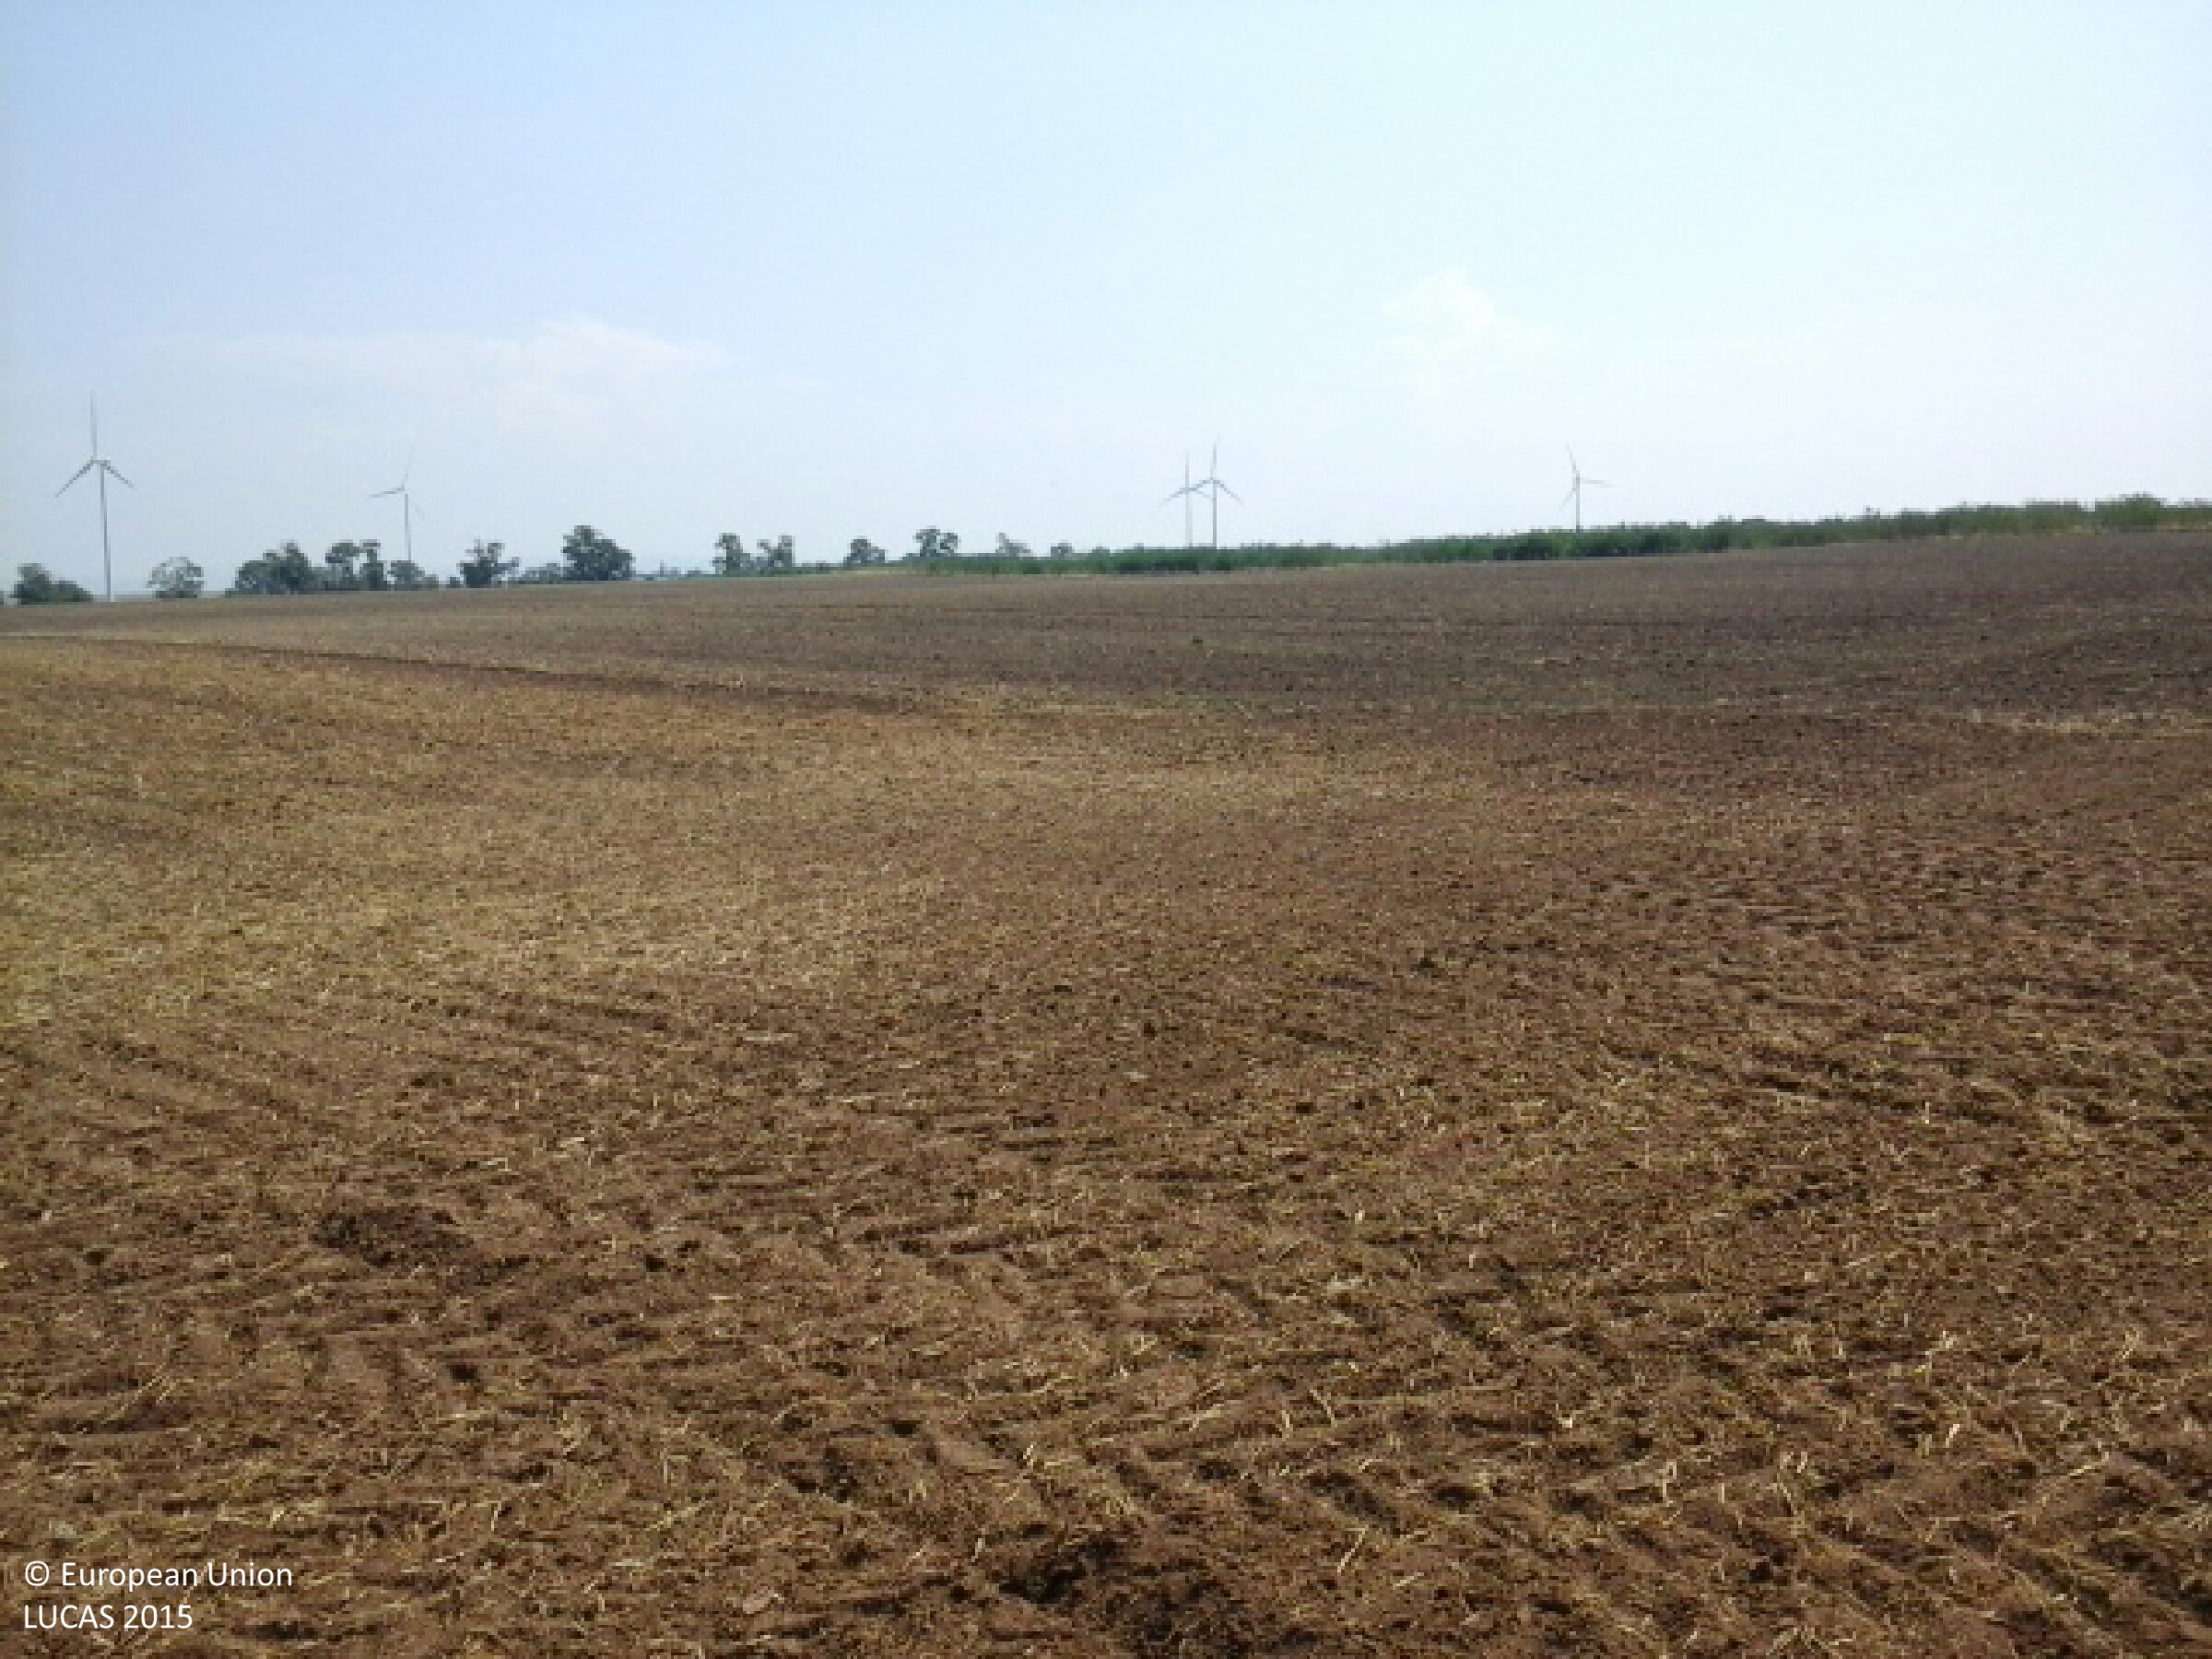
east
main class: Cropland
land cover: Common wheat
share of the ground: < 10 %
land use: Agriculture (excluding fallow land and kitchen gardens)
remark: Harvested field
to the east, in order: Common wheat; Electric lines; Rape and turnip rape
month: August
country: HU
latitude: 47.6186
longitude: 18.0878
